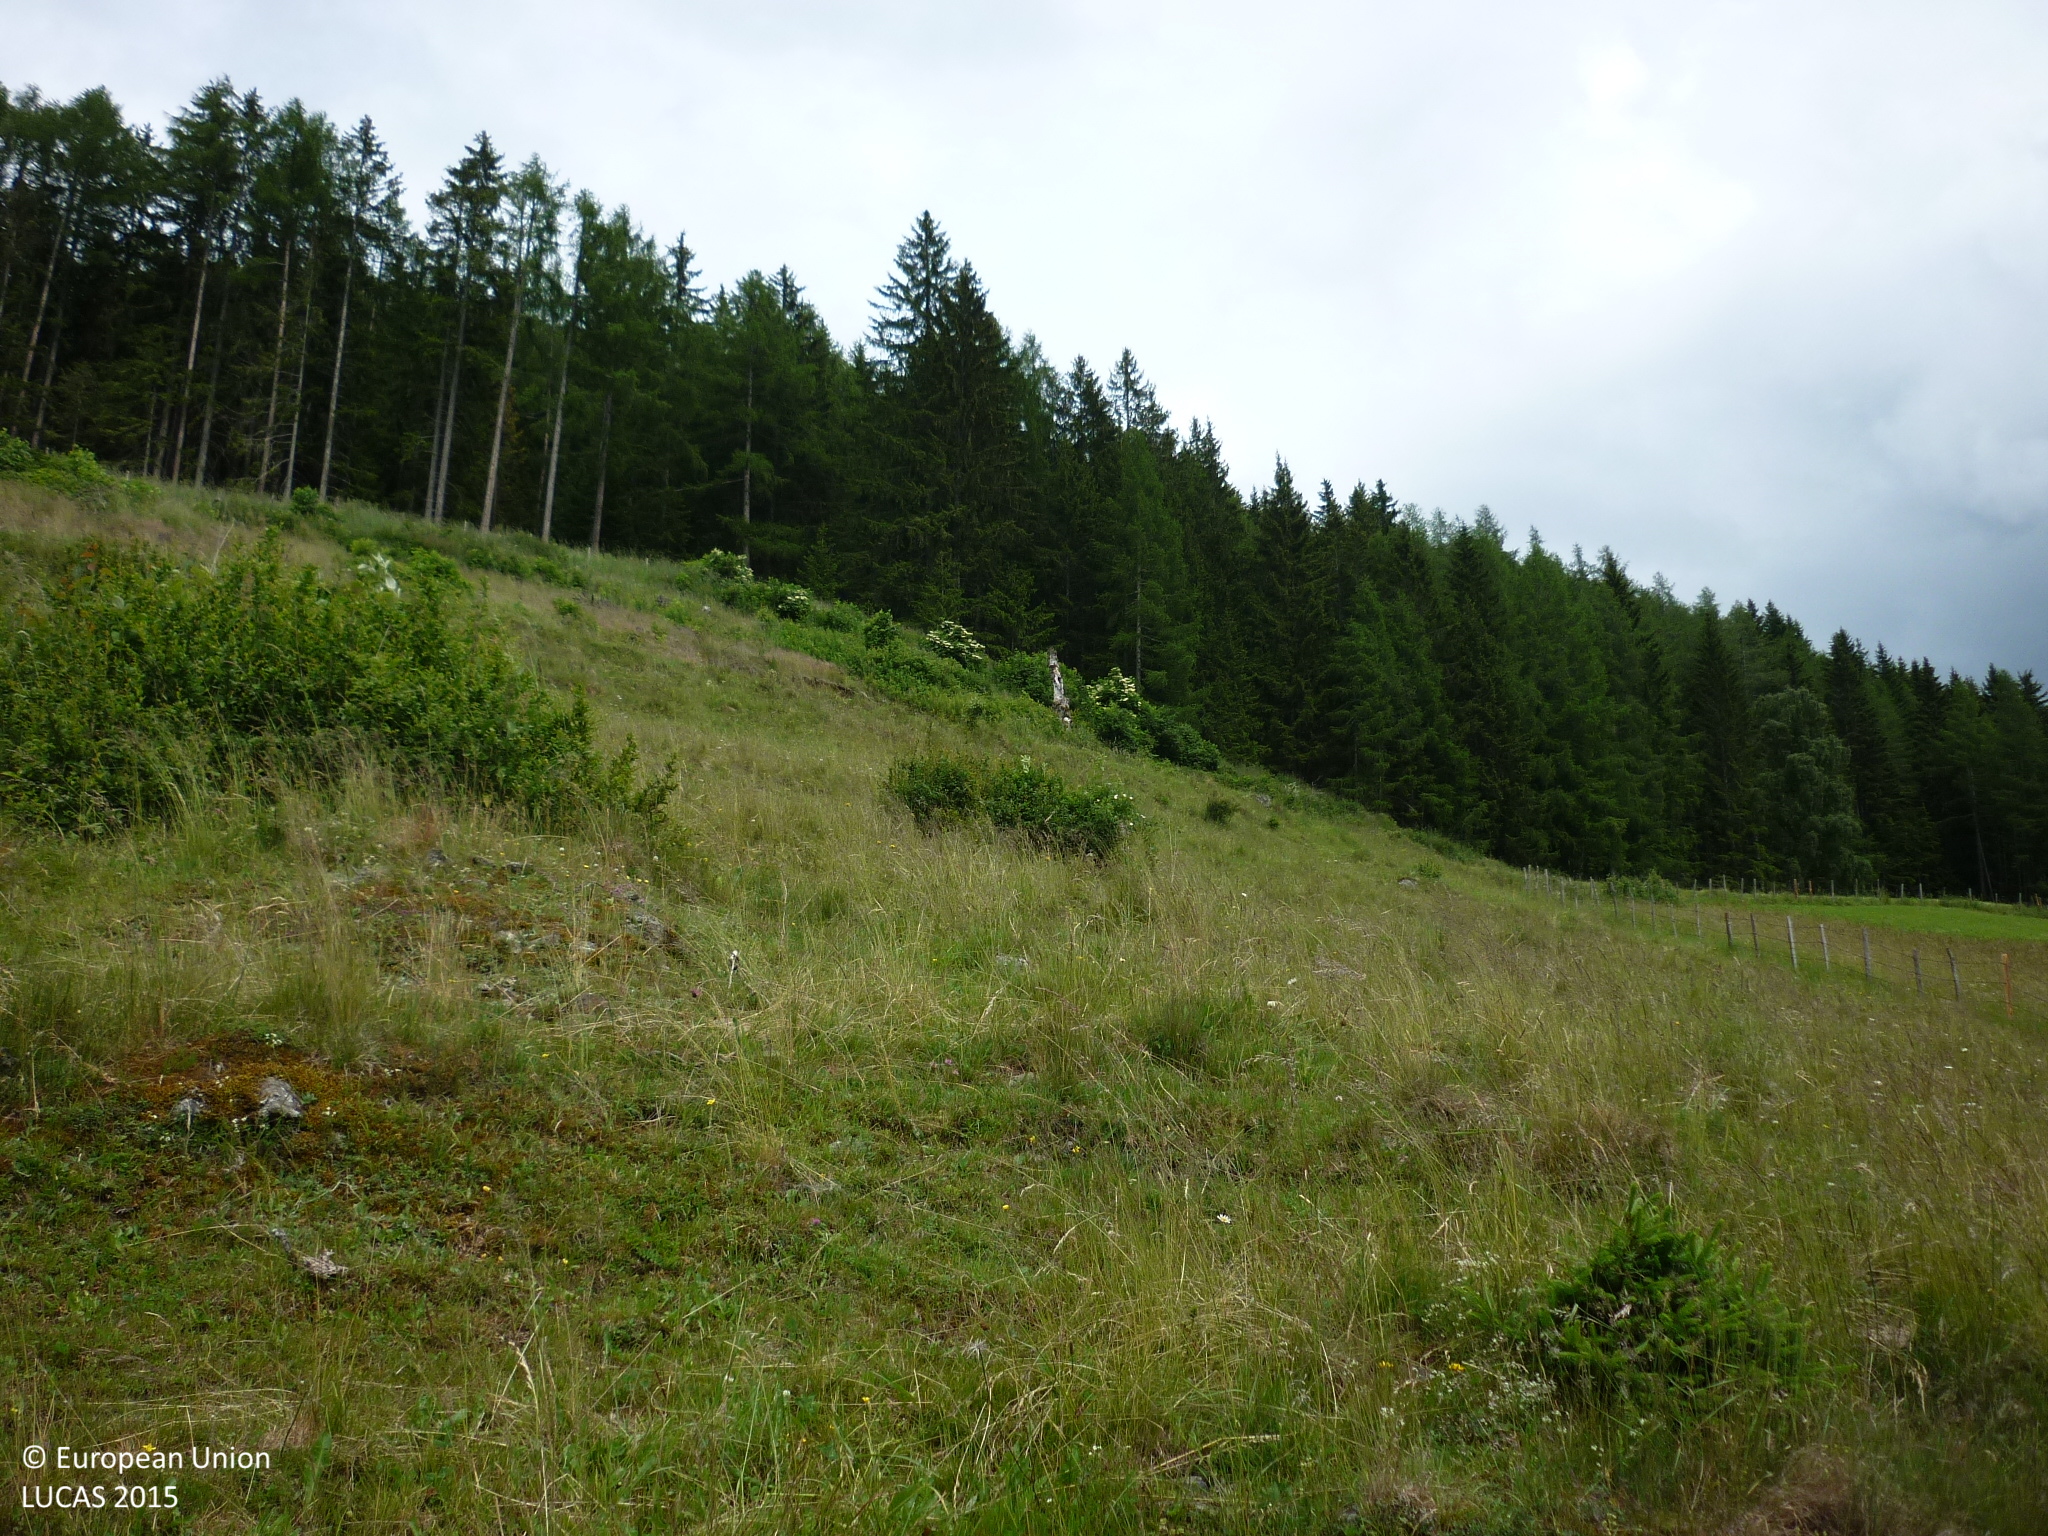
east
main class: Grassland
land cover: Grassland with sparse tree/shrub cover
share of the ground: > 75 %
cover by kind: herbaceous plants 85 %, broadleaved forest trees 5 %, shrubs 5 %, consolidated bare surface 5 %
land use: Agriculture (excluding fallow land and kitchen gardens)
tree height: < 5 m
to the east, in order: Grassland with sparse tree/shrub cover; Tracks; Grassland with sparse tree/shrub cover; Fences; Grassland without tree/shrub cover; Tracks; Spruce dominated coniferous woodland; Tracks; Spruce dominated coniferous woodland
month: June
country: AT
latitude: 47.2019
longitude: 14.3151
